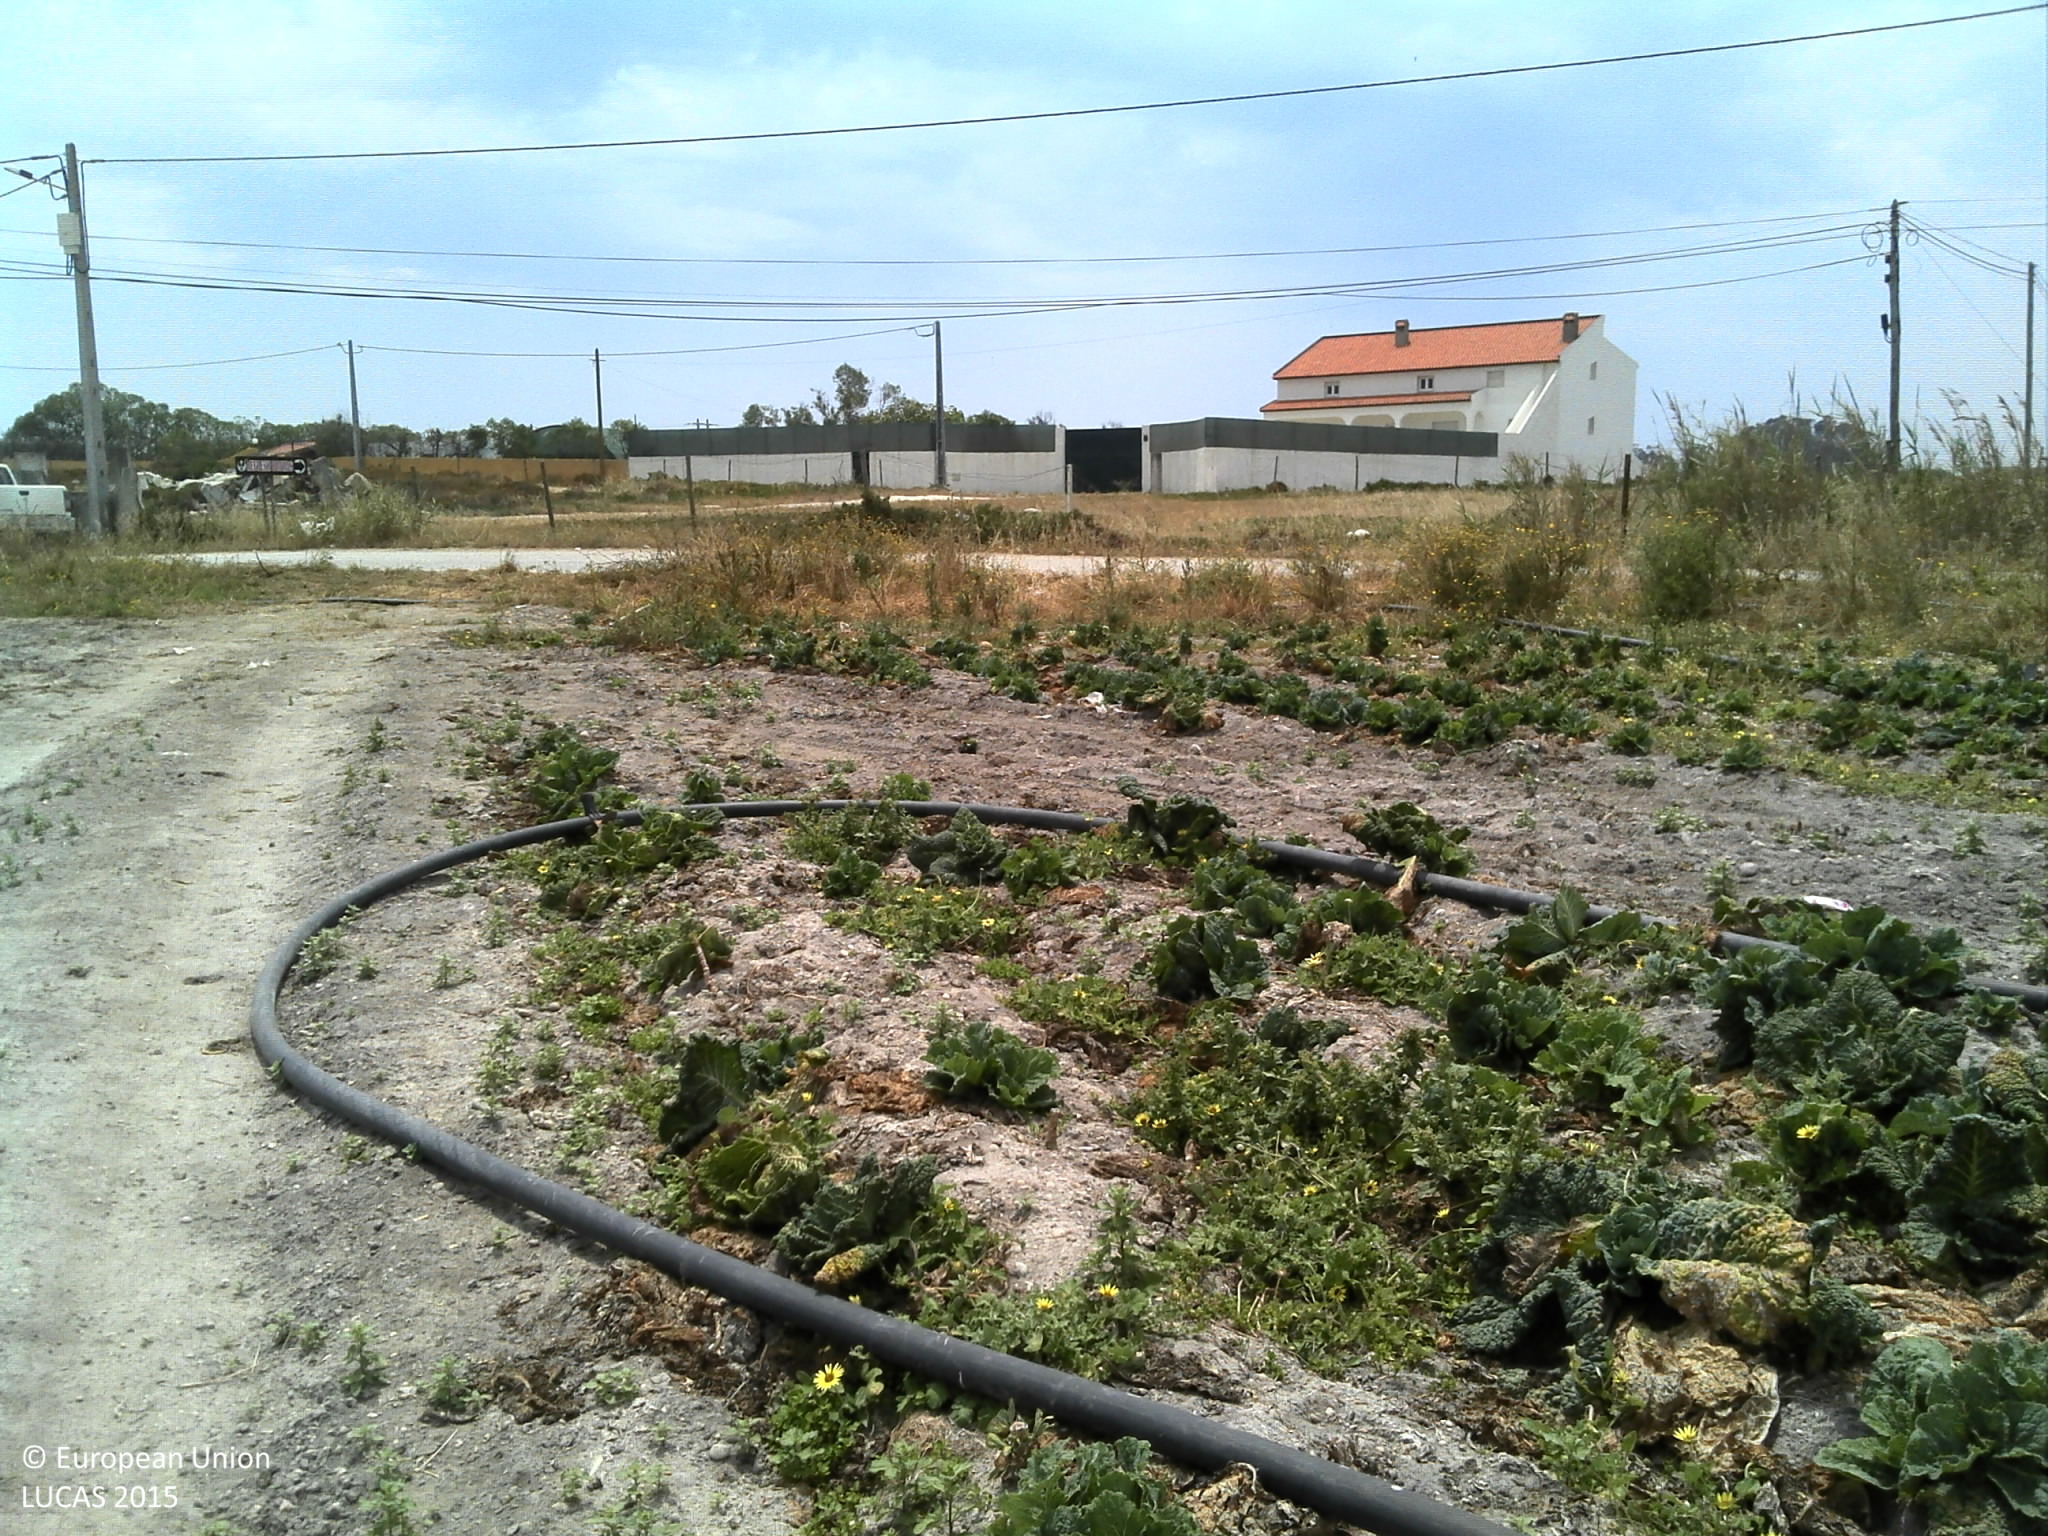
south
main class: Cropland
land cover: Other fresh vegetables
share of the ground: 25 - 50 %
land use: Agriculture (excluding fallow land and kitchen gardens)
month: June
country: PT
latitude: 39.3413
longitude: -9.3426
